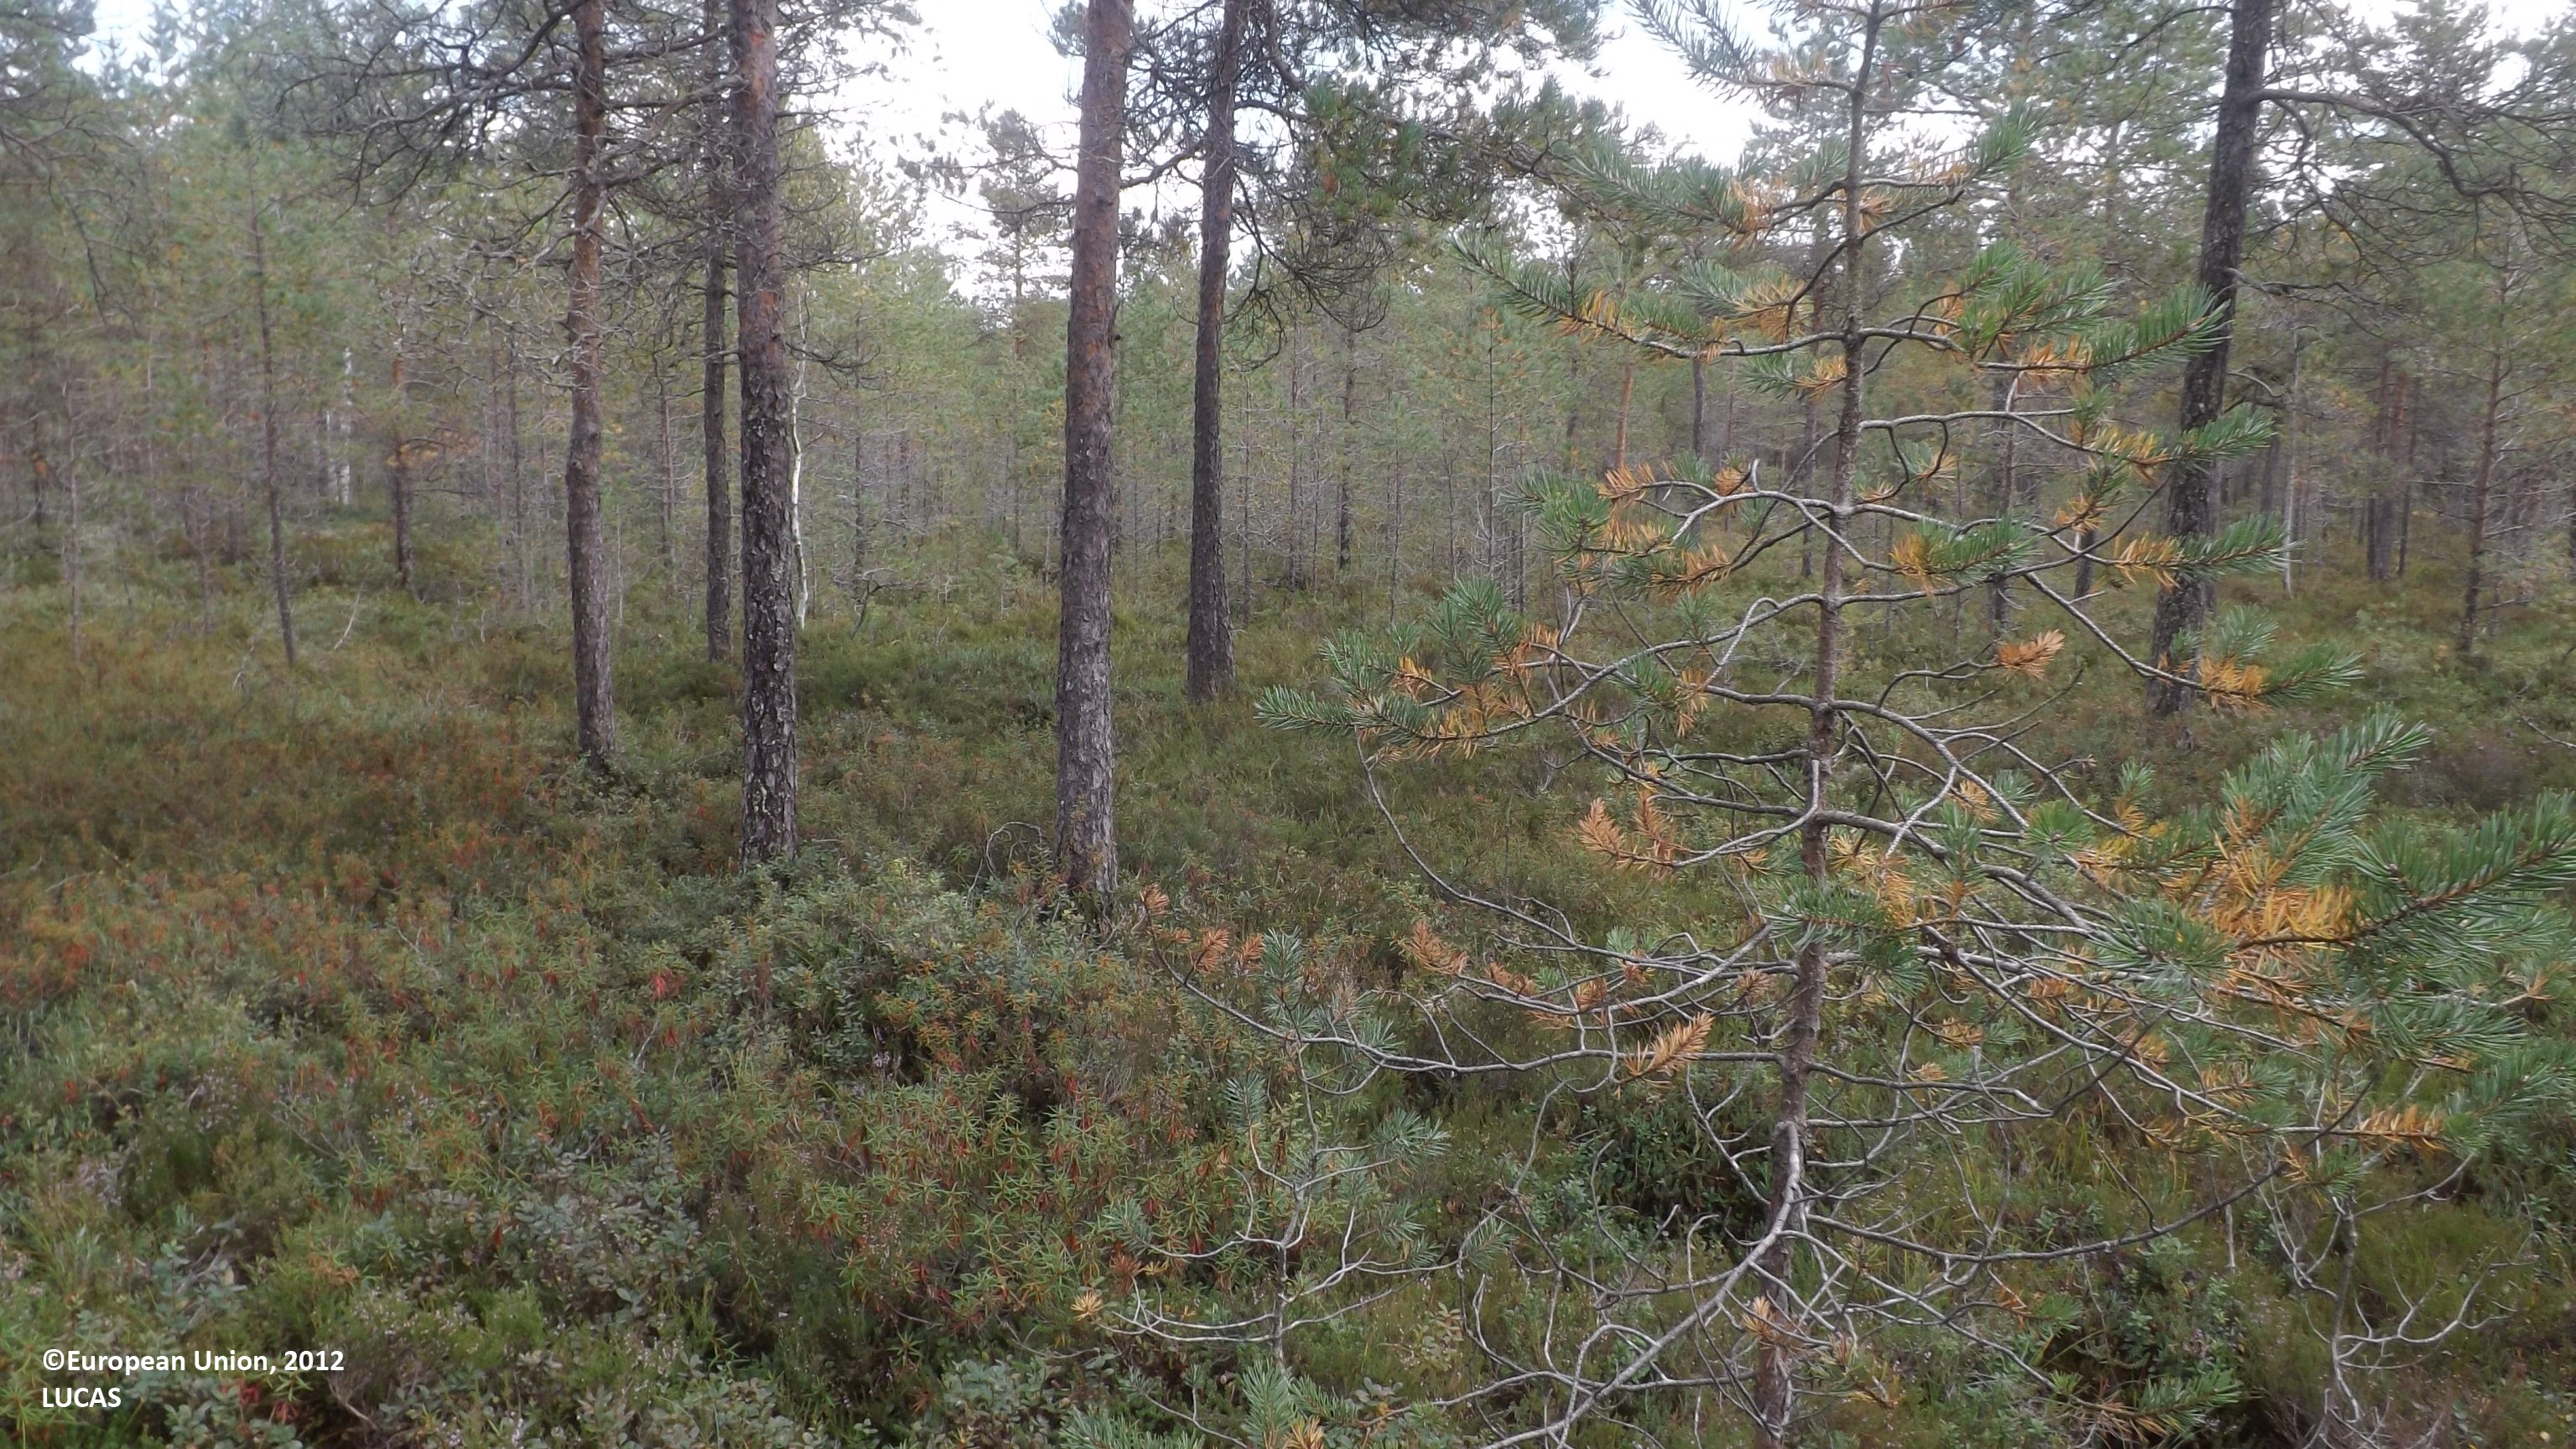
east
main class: Woodland
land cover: Pine dominated coniferous woodland
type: boreal forest
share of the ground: 25 - 50 %
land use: Forestry
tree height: > 5 m
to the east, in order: Pine dominated coniferous woodland; Tracks; Pine dominated coniferous woodland; Ditches and canals; Pine dominated coniferous woodland; Tracks; Ditches and canals; Pine dominated coniferous woodland
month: August
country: FI
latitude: 63.9005
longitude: 23.6081
